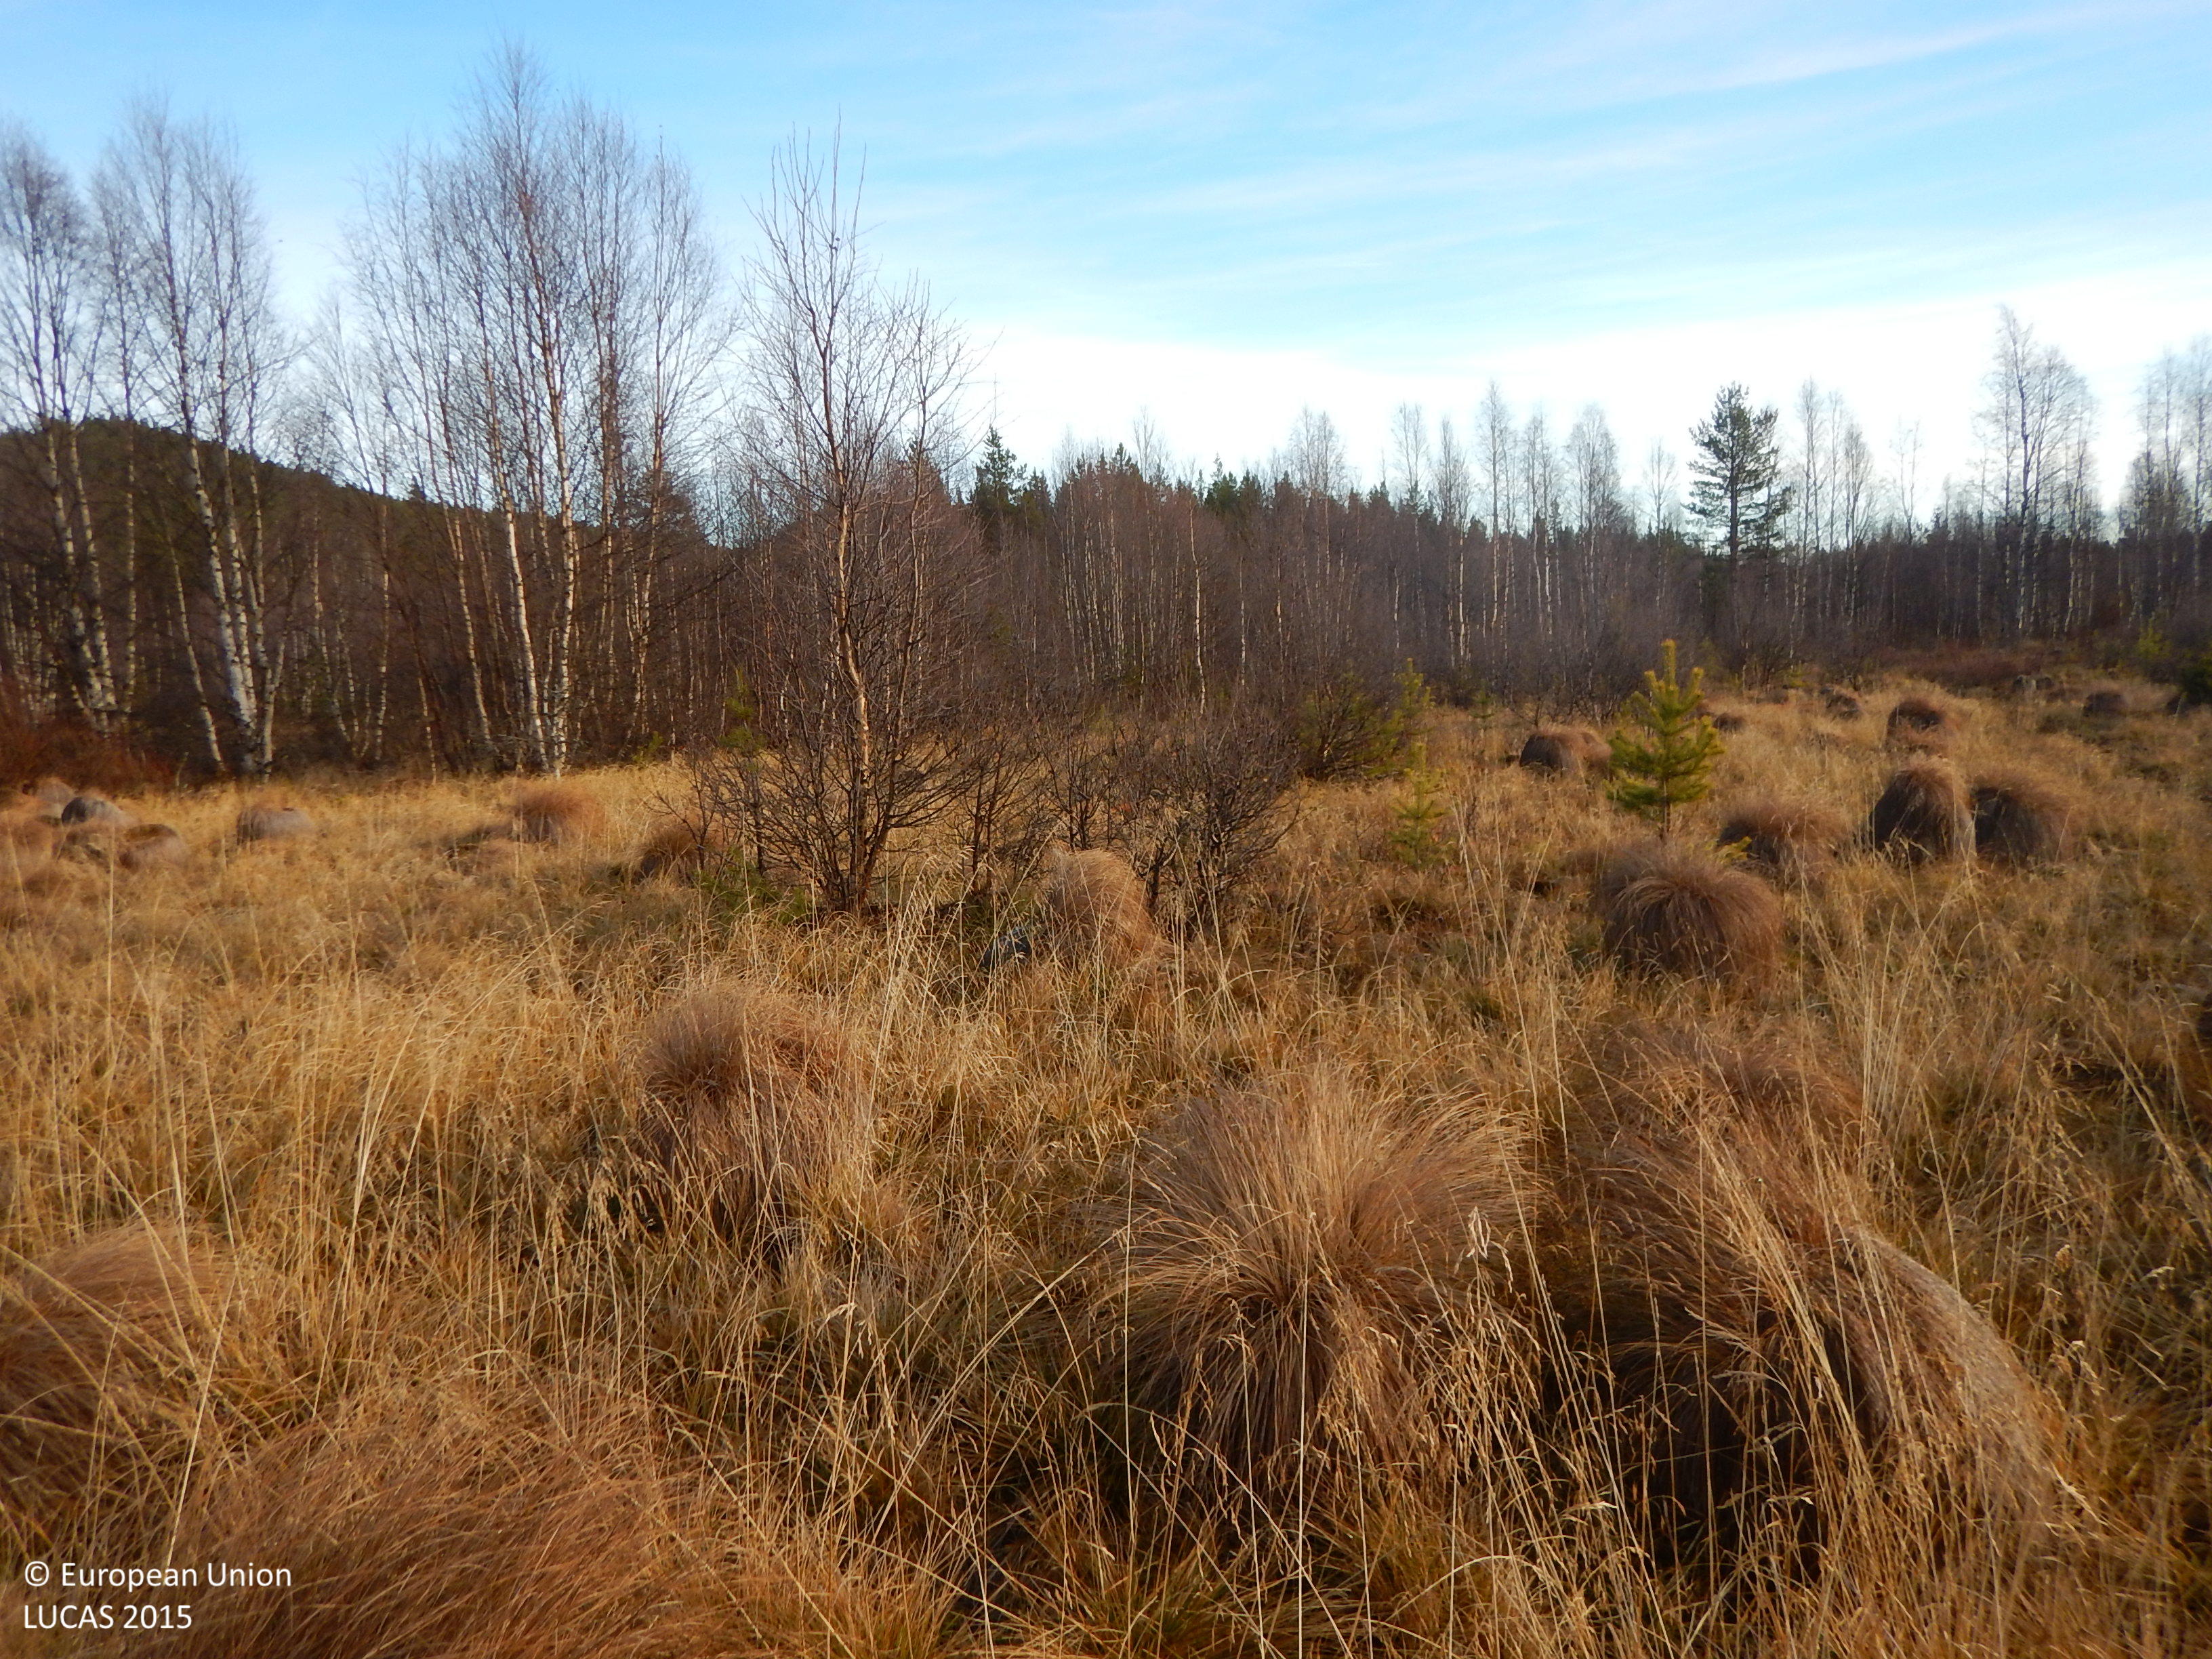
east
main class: Grassland
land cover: Grassland without tree/shrub cover
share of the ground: > 75 %
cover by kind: herbaceous plants 80 %, lichens and mosses 20 %
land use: Abandoned areas
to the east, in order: Grassland without tree/shrub cover; Broadleaved woodland; Ditches and canals; Broadleaved woodland; Ditches and canals; Broadleaved woodland; Ditches and canals; Shrubland with sparse tree cover; Broadleaved woodland; Spruce dominated mixed woodland
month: October
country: SE
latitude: 65.3353
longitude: 20.0817
